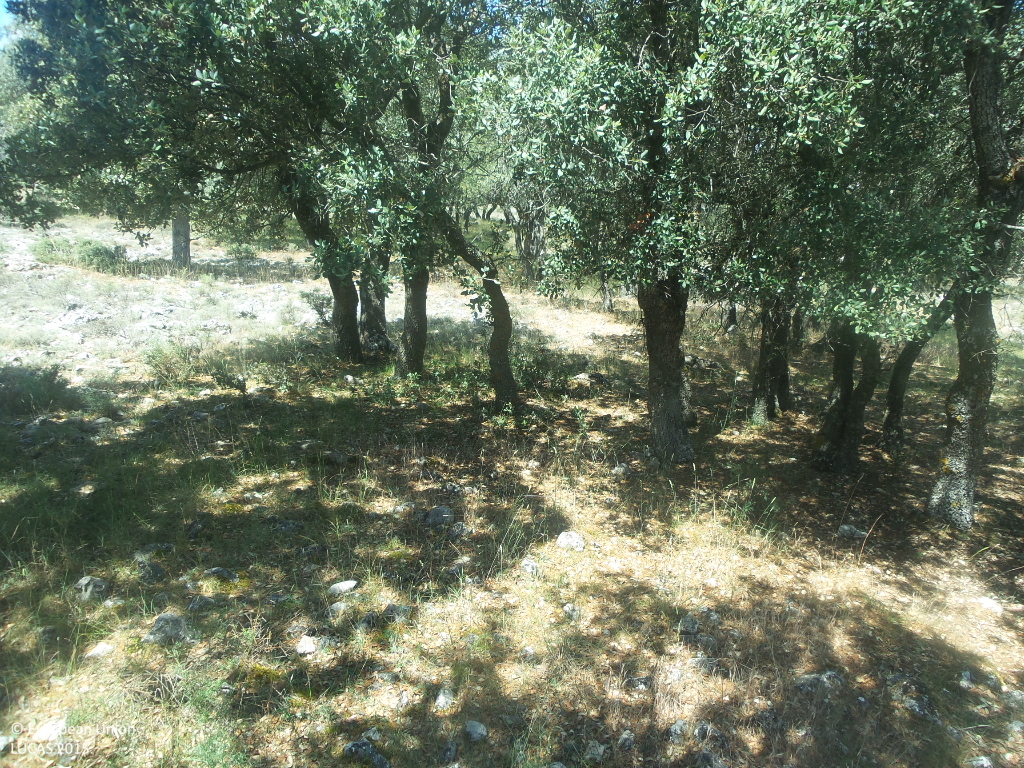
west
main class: Woodland
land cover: Broadleaved woodland
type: broadleaved evergreen forest
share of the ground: 50 - 75 %
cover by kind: broadleaved forest trees 60 %, unconsolidated bare surface 25 %, shrubs 5 %, herbaceous plants 5 %, lichens and mosses 5 %
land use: Semi-natural and natural areas not in use
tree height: > 5 m
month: June
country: ES
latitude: 41.4076
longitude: -3.0200
